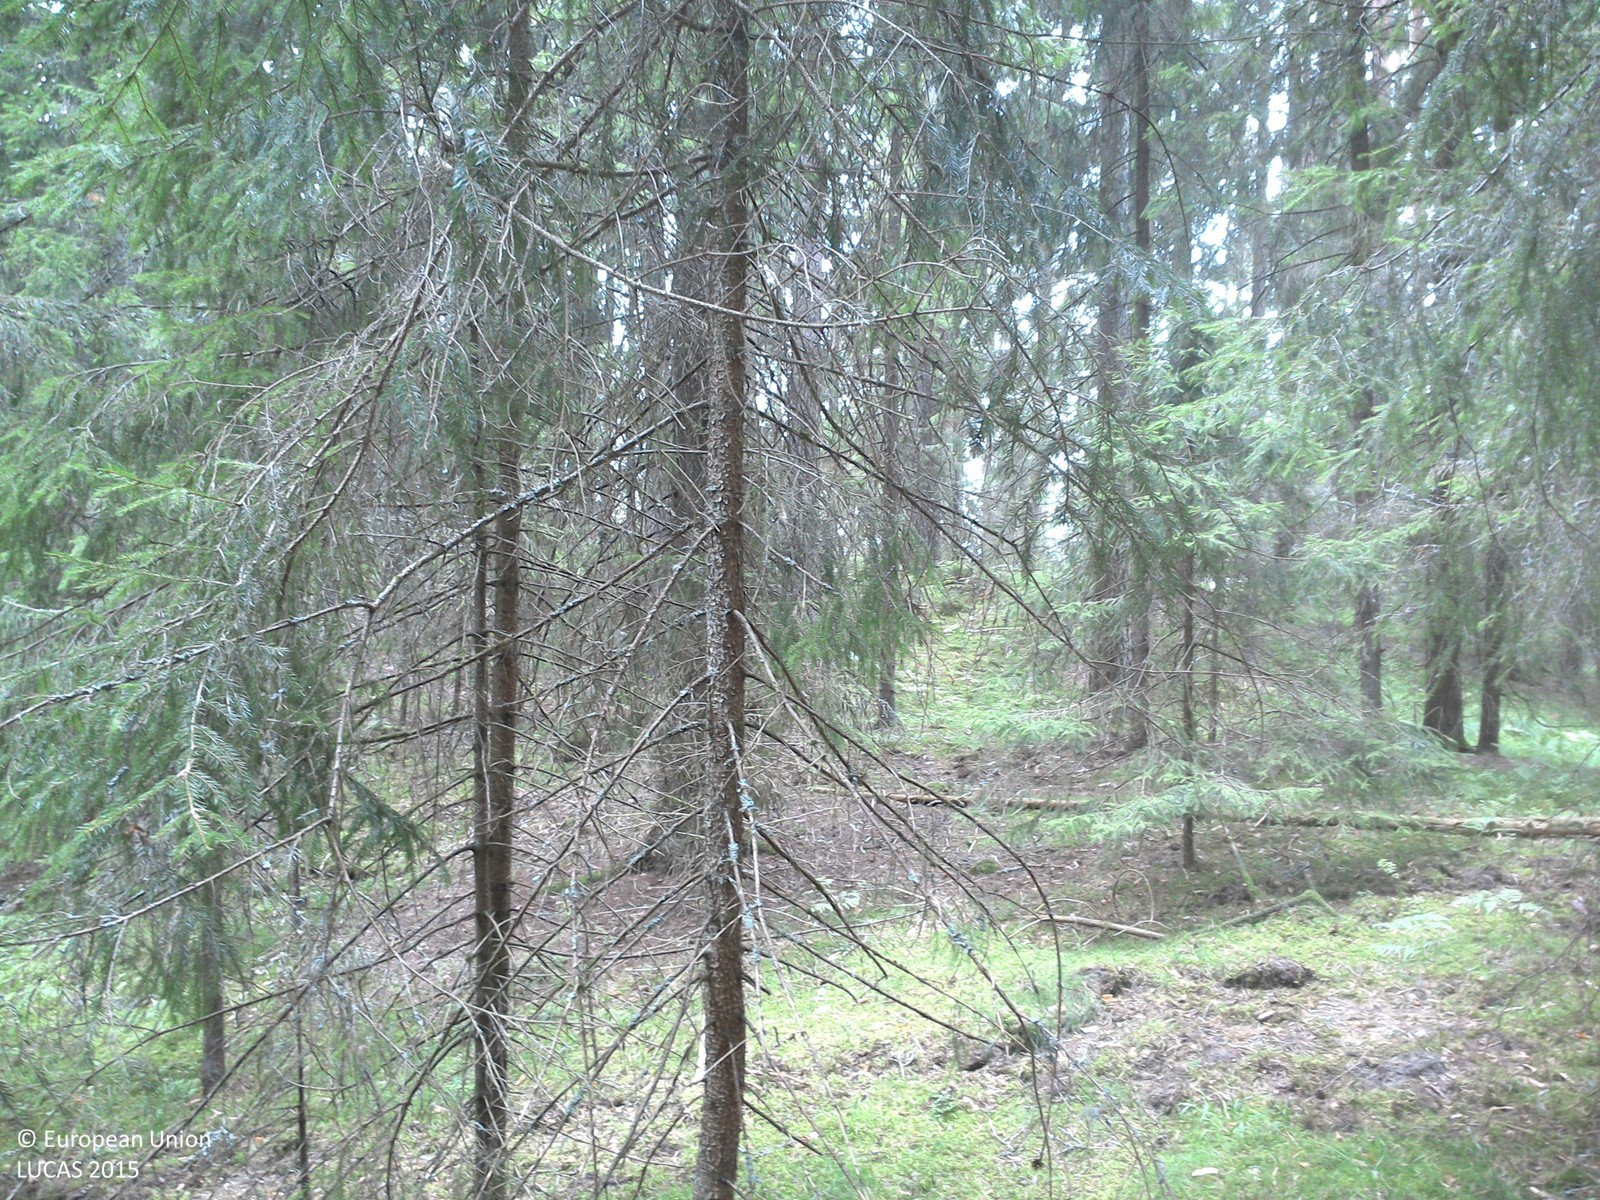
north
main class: Woodland
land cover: Spruce dominated coniferous woodland
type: boreal forest
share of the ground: 50 - 75 %
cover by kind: coniferous forest trees 60 %, herbaceous plants 20 %, lichens and mosses 20 %
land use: Forestry
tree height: > 5 m
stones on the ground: < 10 %
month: August
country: SE
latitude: 57.9811
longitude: 15.4914
